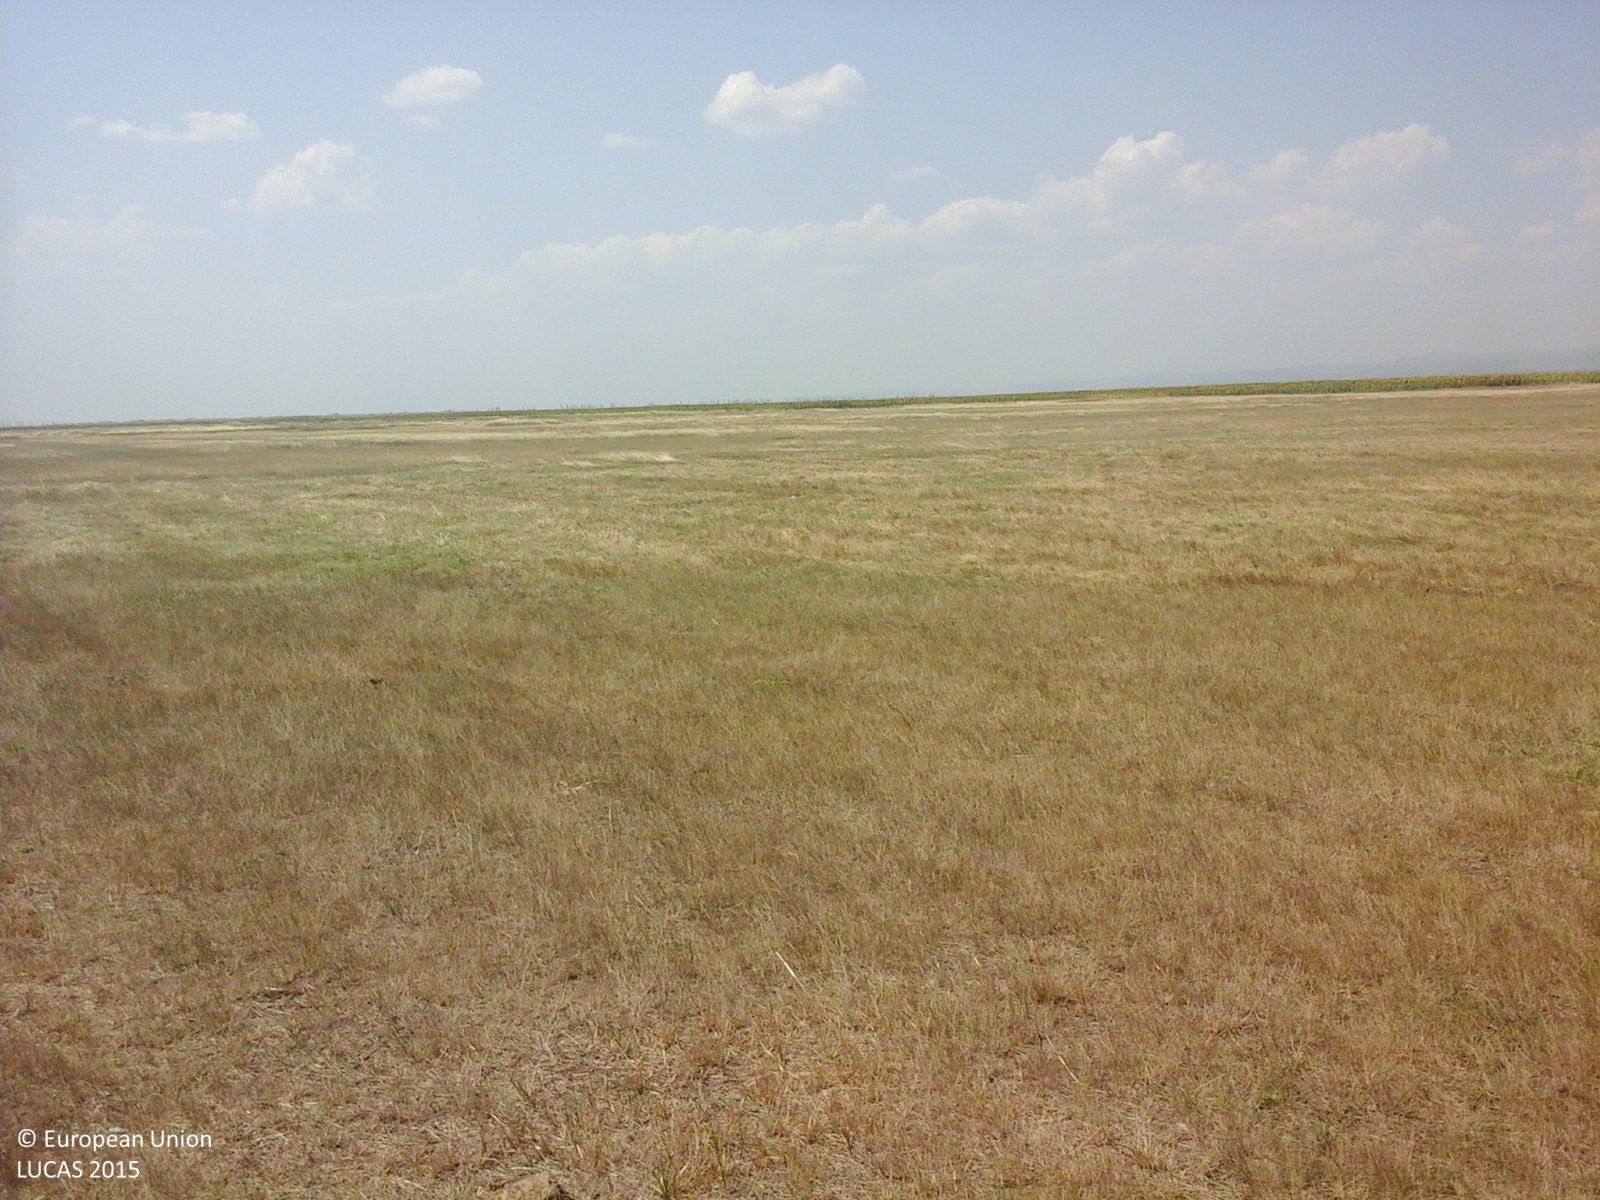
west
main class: Grassland
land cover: Grassland without tree/shrub cover
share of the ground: > 75 %
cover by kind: herbaceous plants 100 %
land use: Agriculture (excluding fallow land and kitchen gardens)
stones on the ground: < 10 %
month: August
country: RO
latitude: 44.9971
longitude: 26.6536
